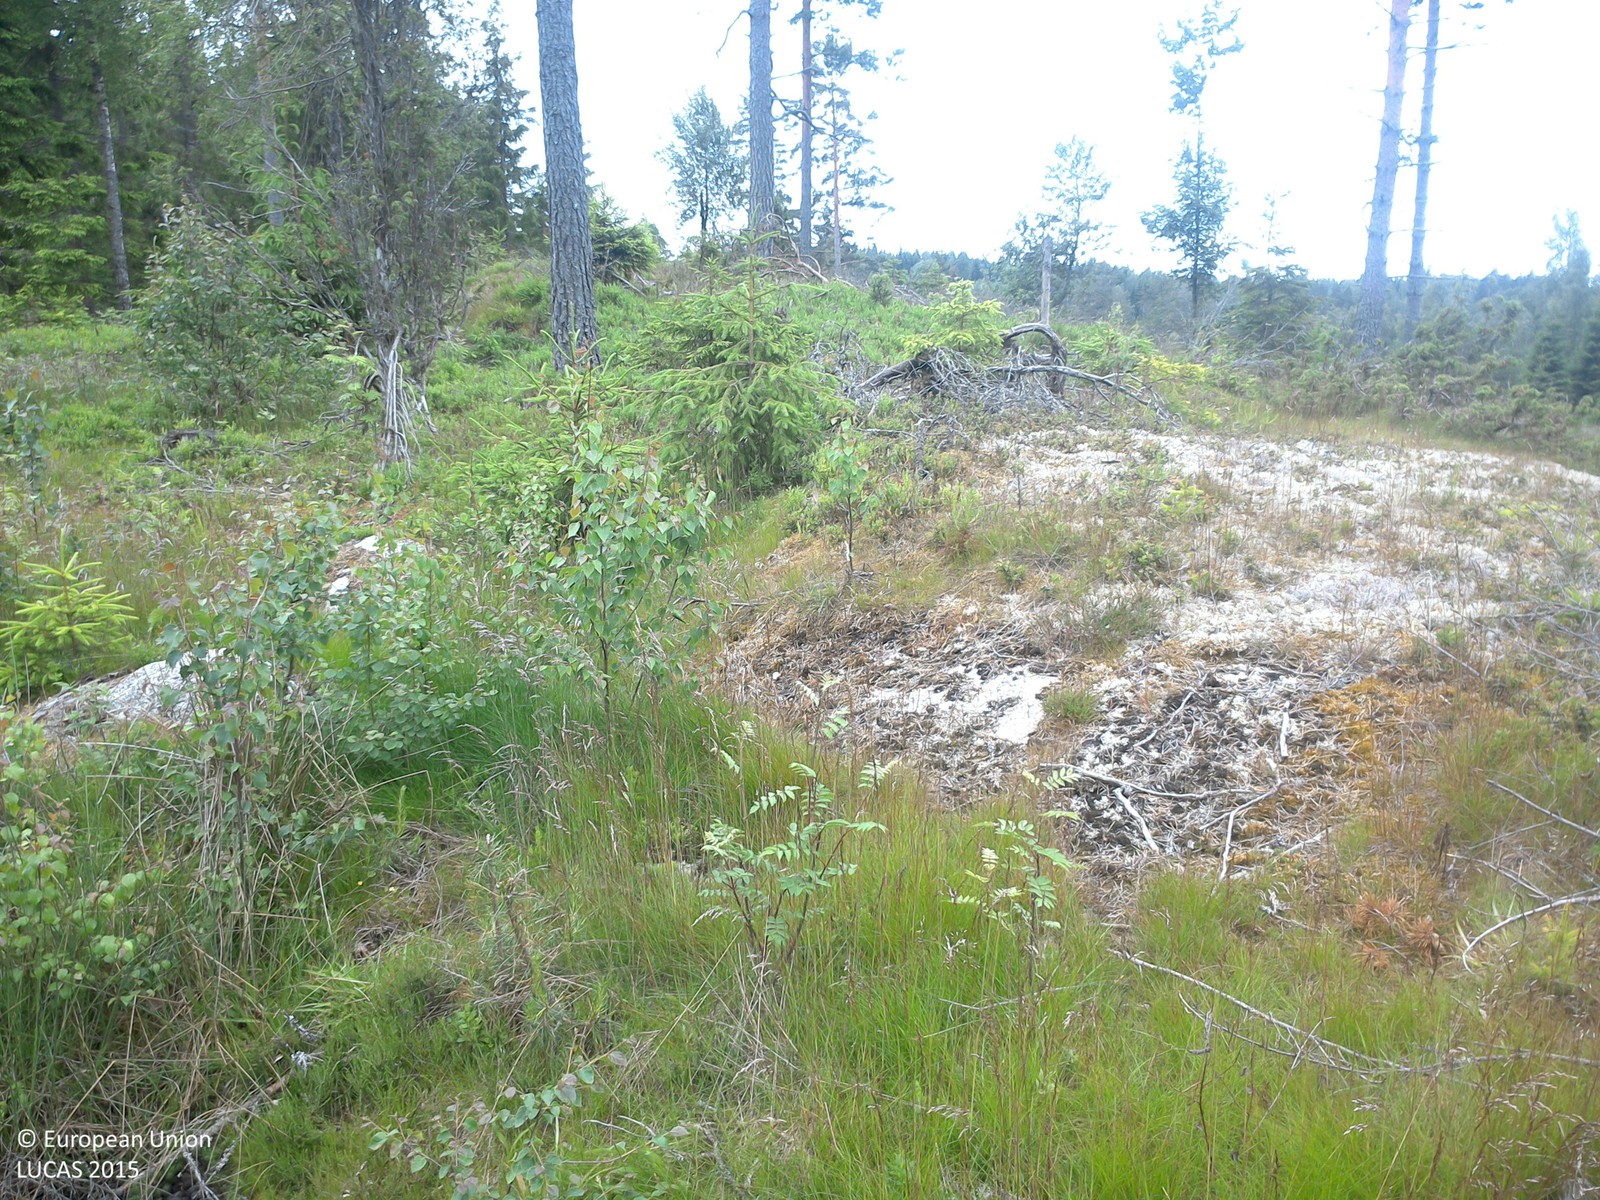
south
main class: Woodland
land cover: Pine dominated coniferous woodland
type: boreal forest
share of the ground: 10 - 25 %
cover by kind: herbaceous plants 45 %, lichens and mosses 40 %, coniferous forest trees 15 %
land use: Forestry
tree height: > 5 m
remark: Clear cut
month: June
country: SE
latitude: 58.1452
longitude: 15.4482
